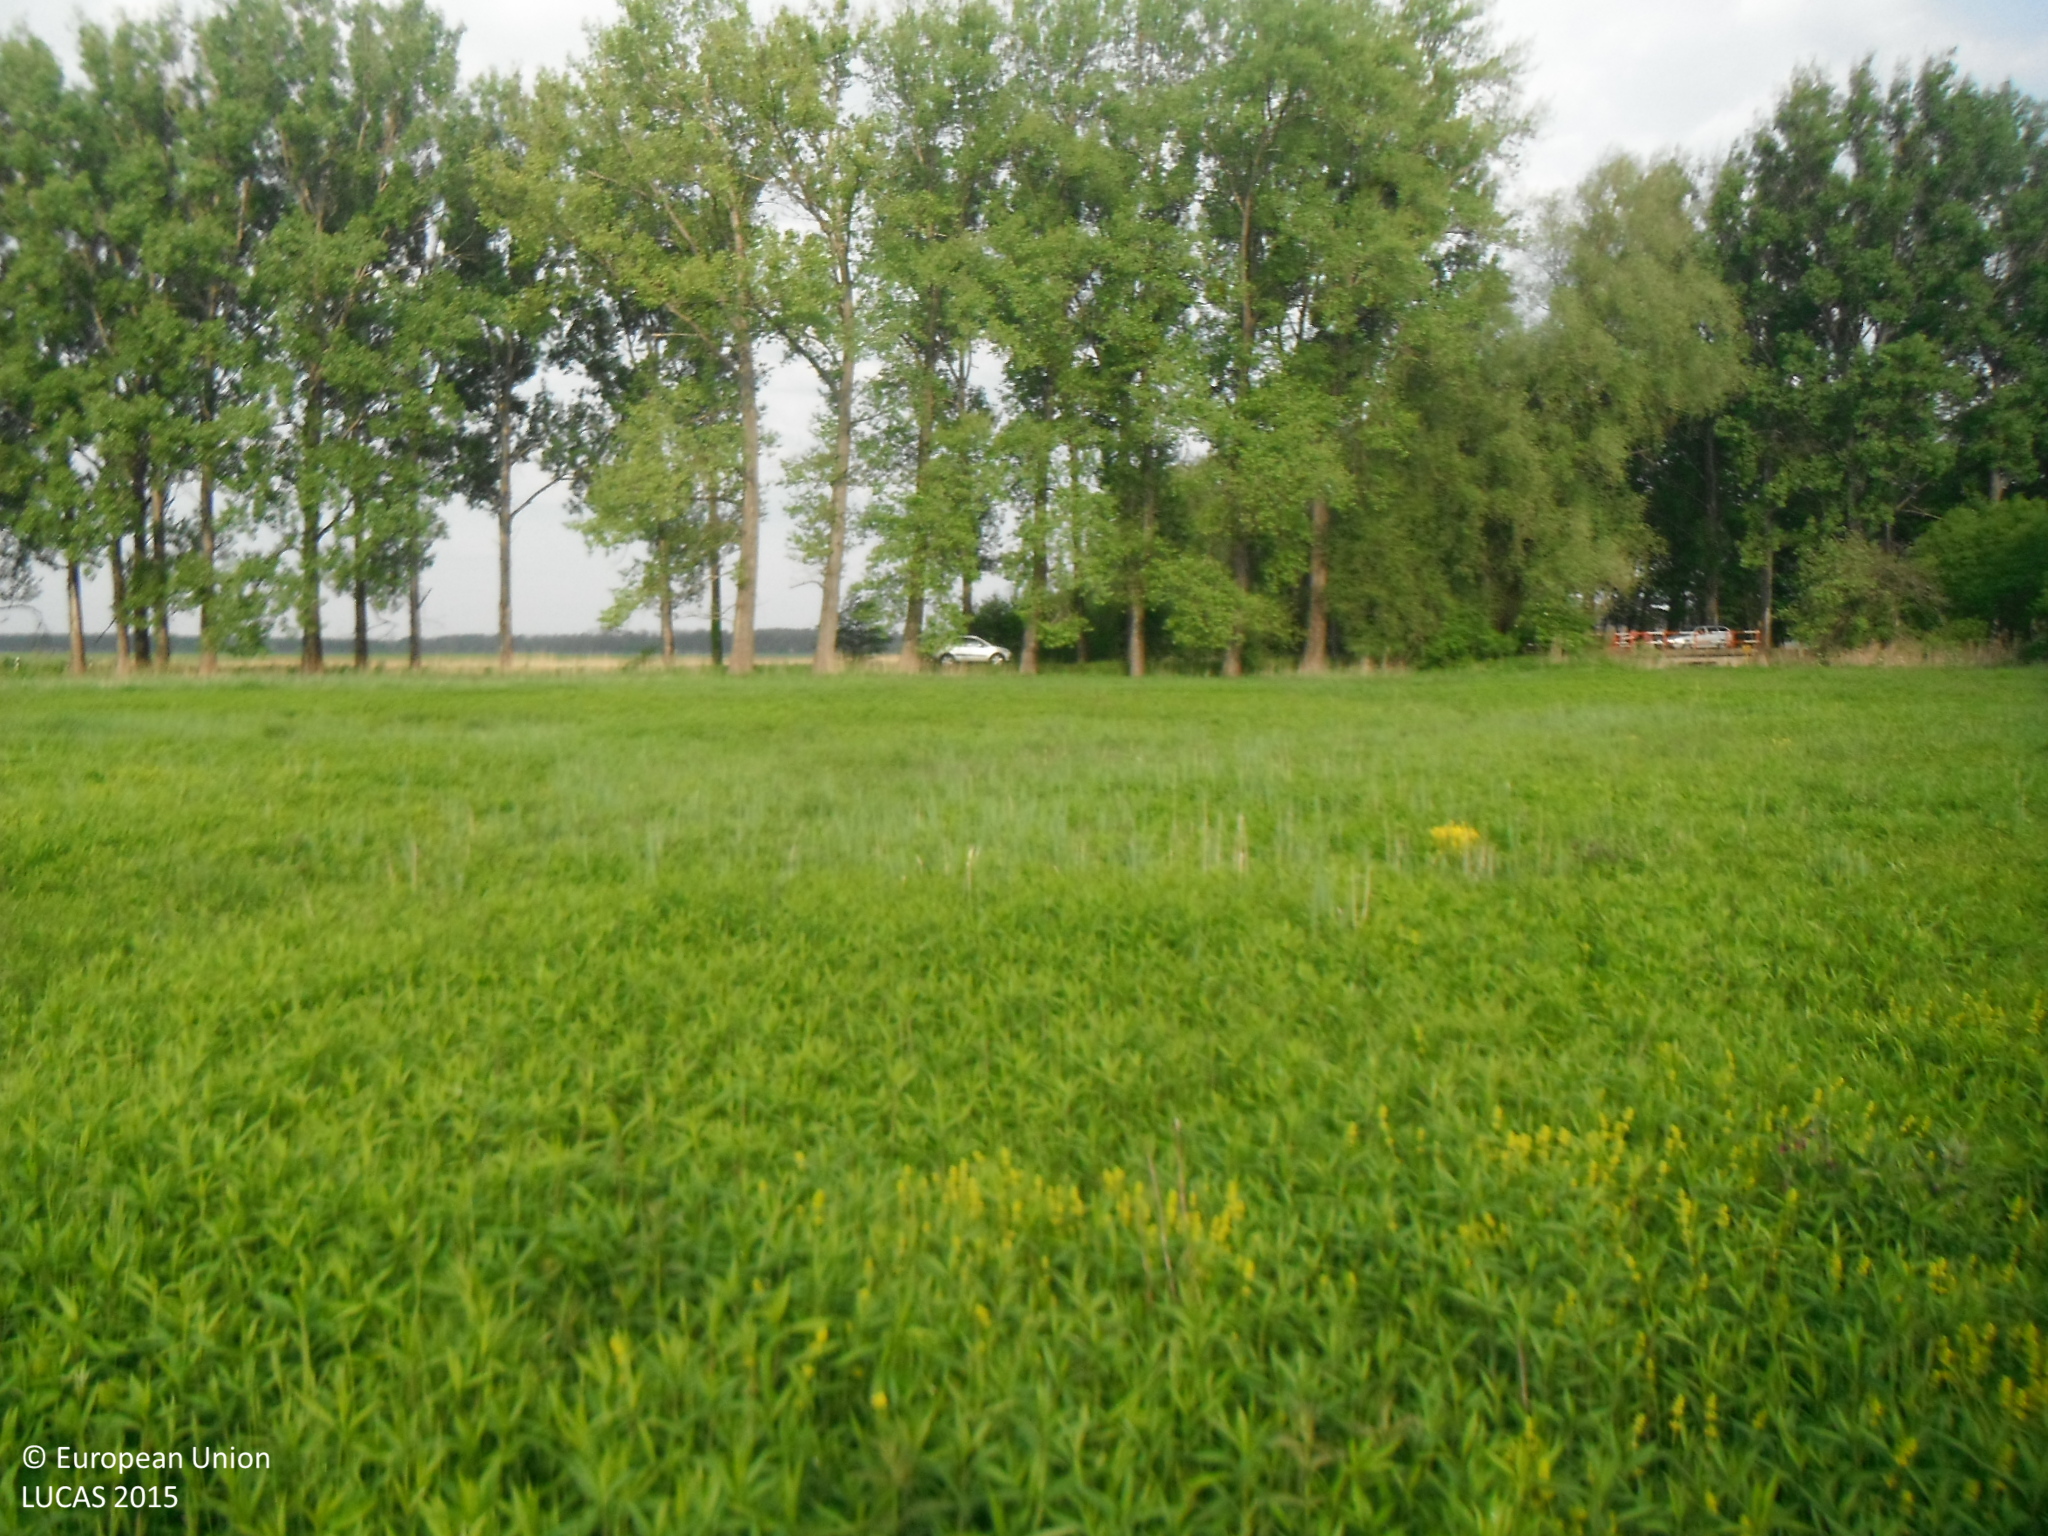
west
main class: Grassland
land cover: Spontaneously vegetated surfaces
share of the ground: > 75 %
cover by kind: herbaceous plants 100 %
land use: Semi-natural and natural areas not in use
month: May
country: SK
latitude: 48.3902
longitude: 17.1254
